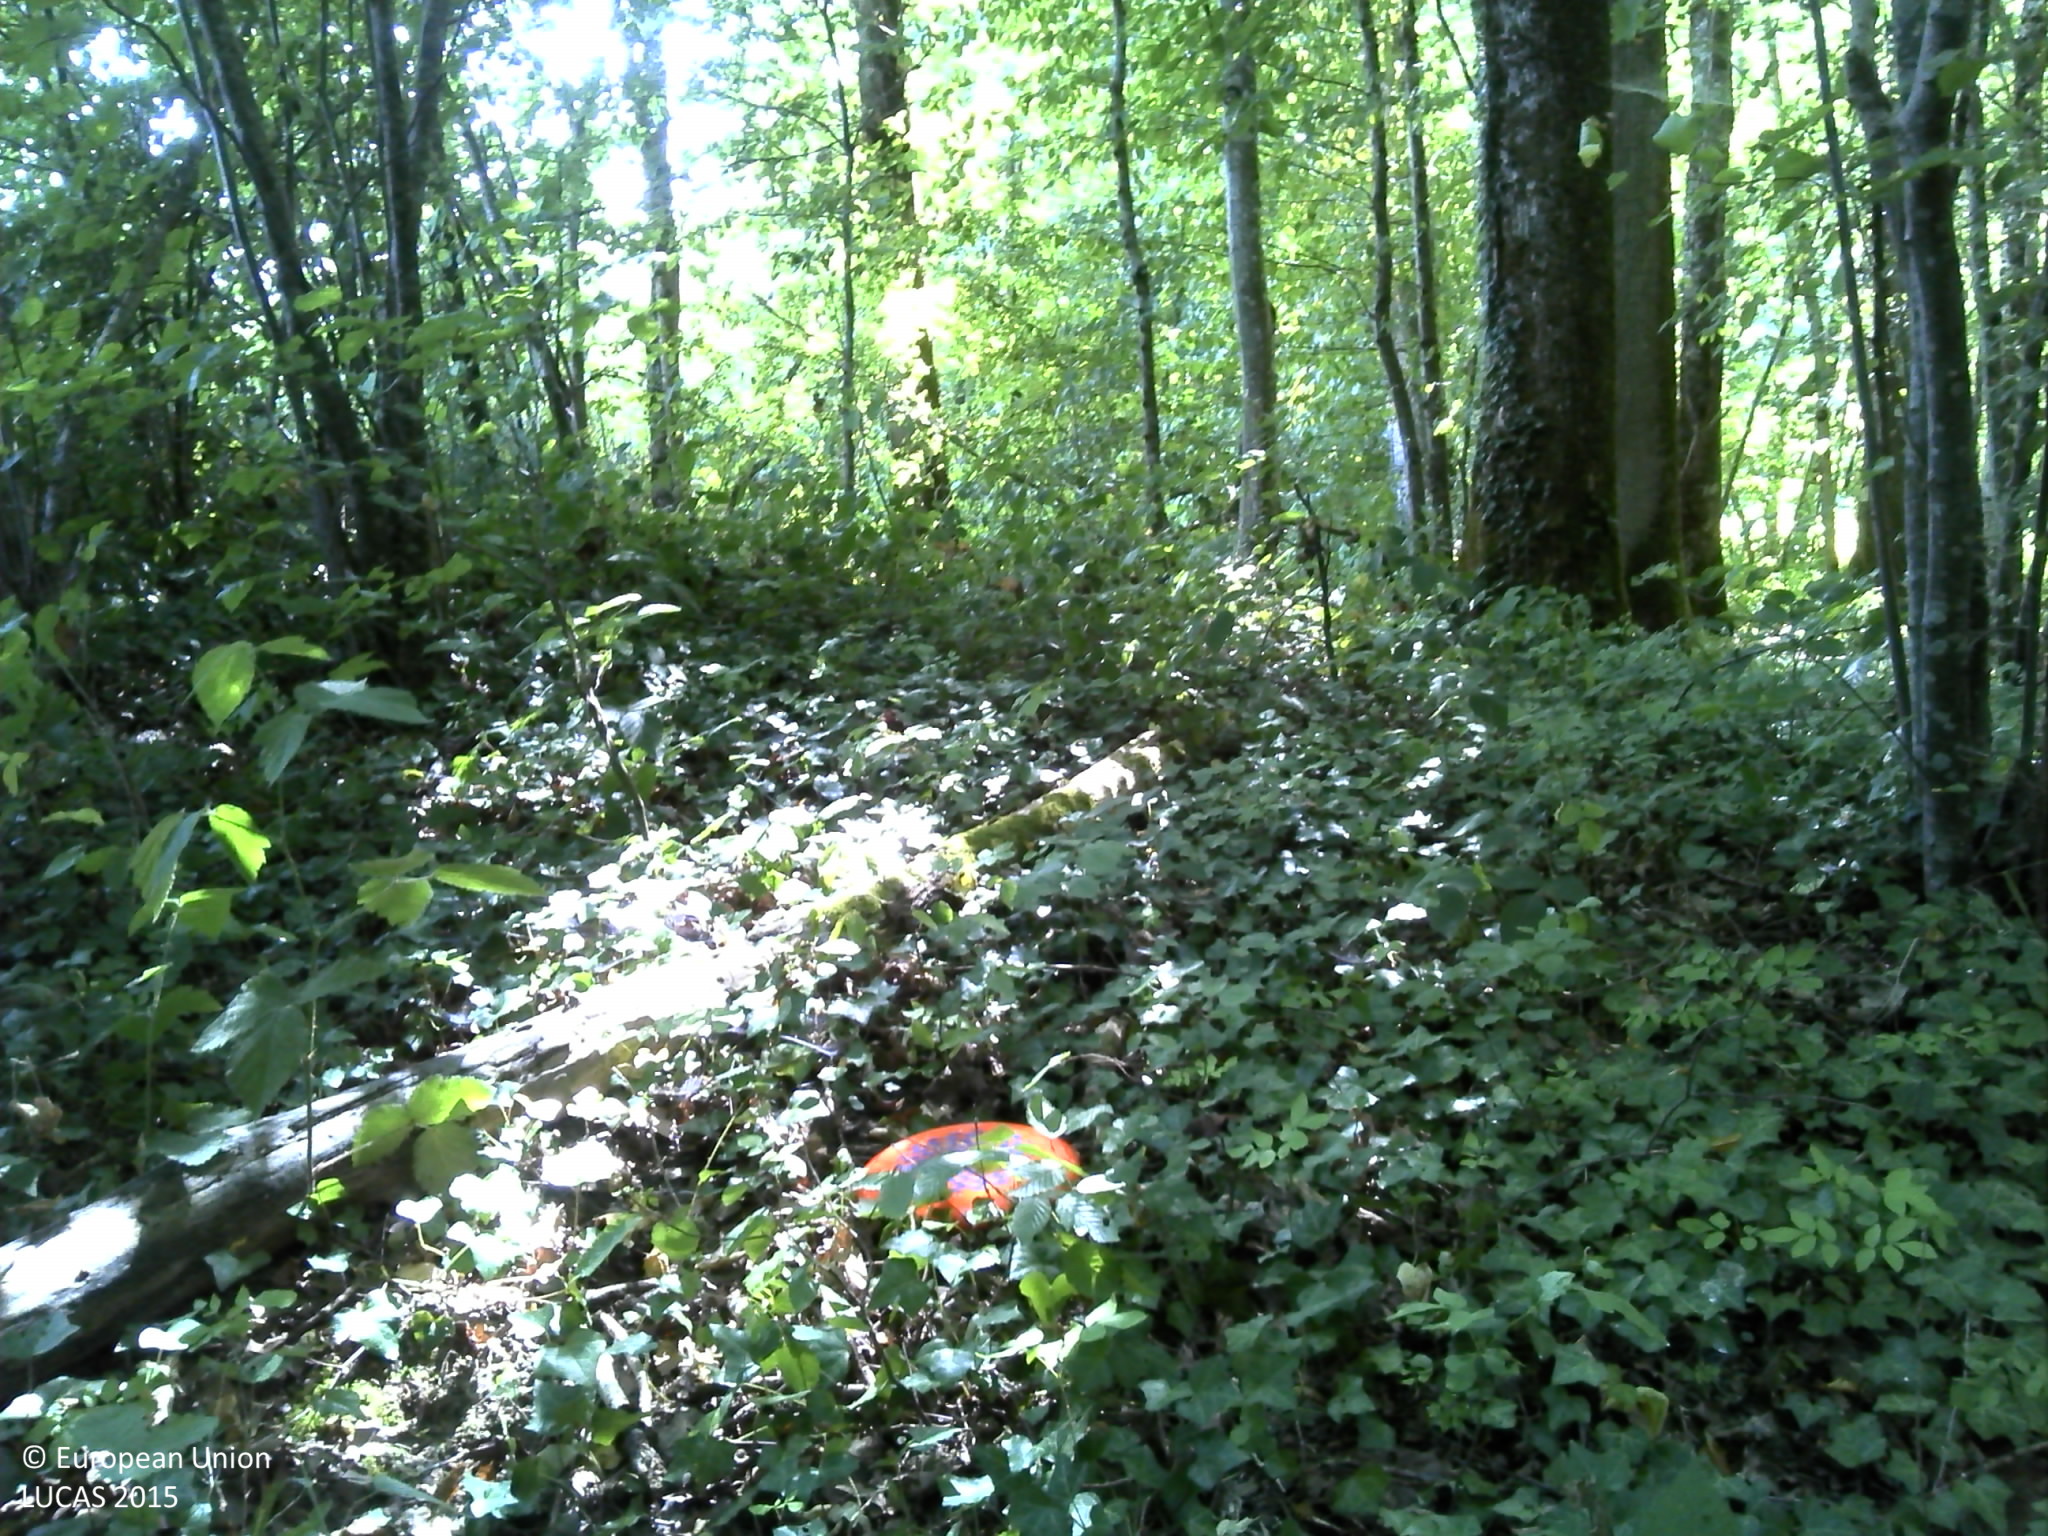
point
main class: Woodland
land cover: Broadleaved woodland
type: beech forest
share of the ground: > 75 %
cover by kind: broadleaved forest trees 90 %, coniferous forest trees 10 %
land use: Forestry
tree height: > 5 m
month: July
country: FR
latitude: 48.8800
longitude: 4.8842
